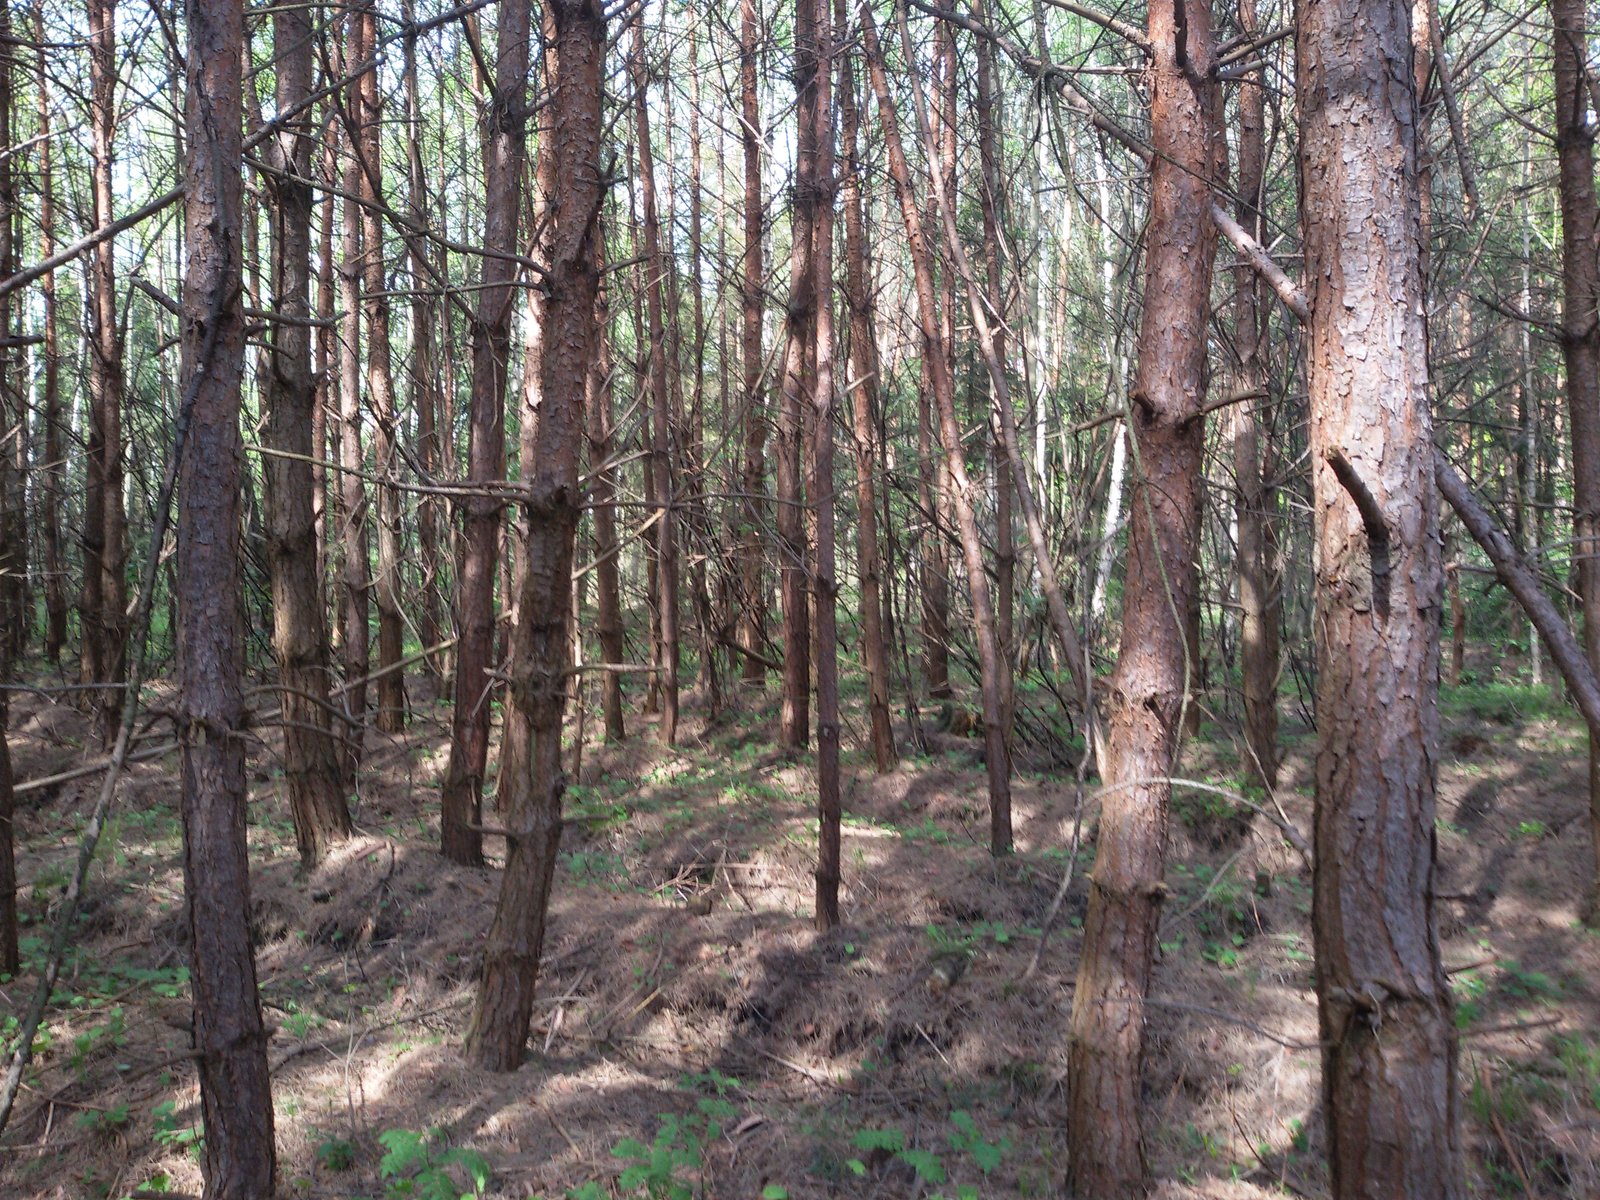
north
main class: Woodland
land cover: Pine dominated coniferous woodland
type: hemiboreal forest and nemoral coniferous forest and mixed broadleaved-coniferous forest
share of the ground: > 75 %
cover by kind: coniferous forest trees 75 %, broadleaved forest trees 10 %, herbaceous plants 10 %, shrubs 5 %
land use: Forestry
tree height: > 5 m
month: May
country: PL
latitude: 50.2700
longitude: 21.3425
